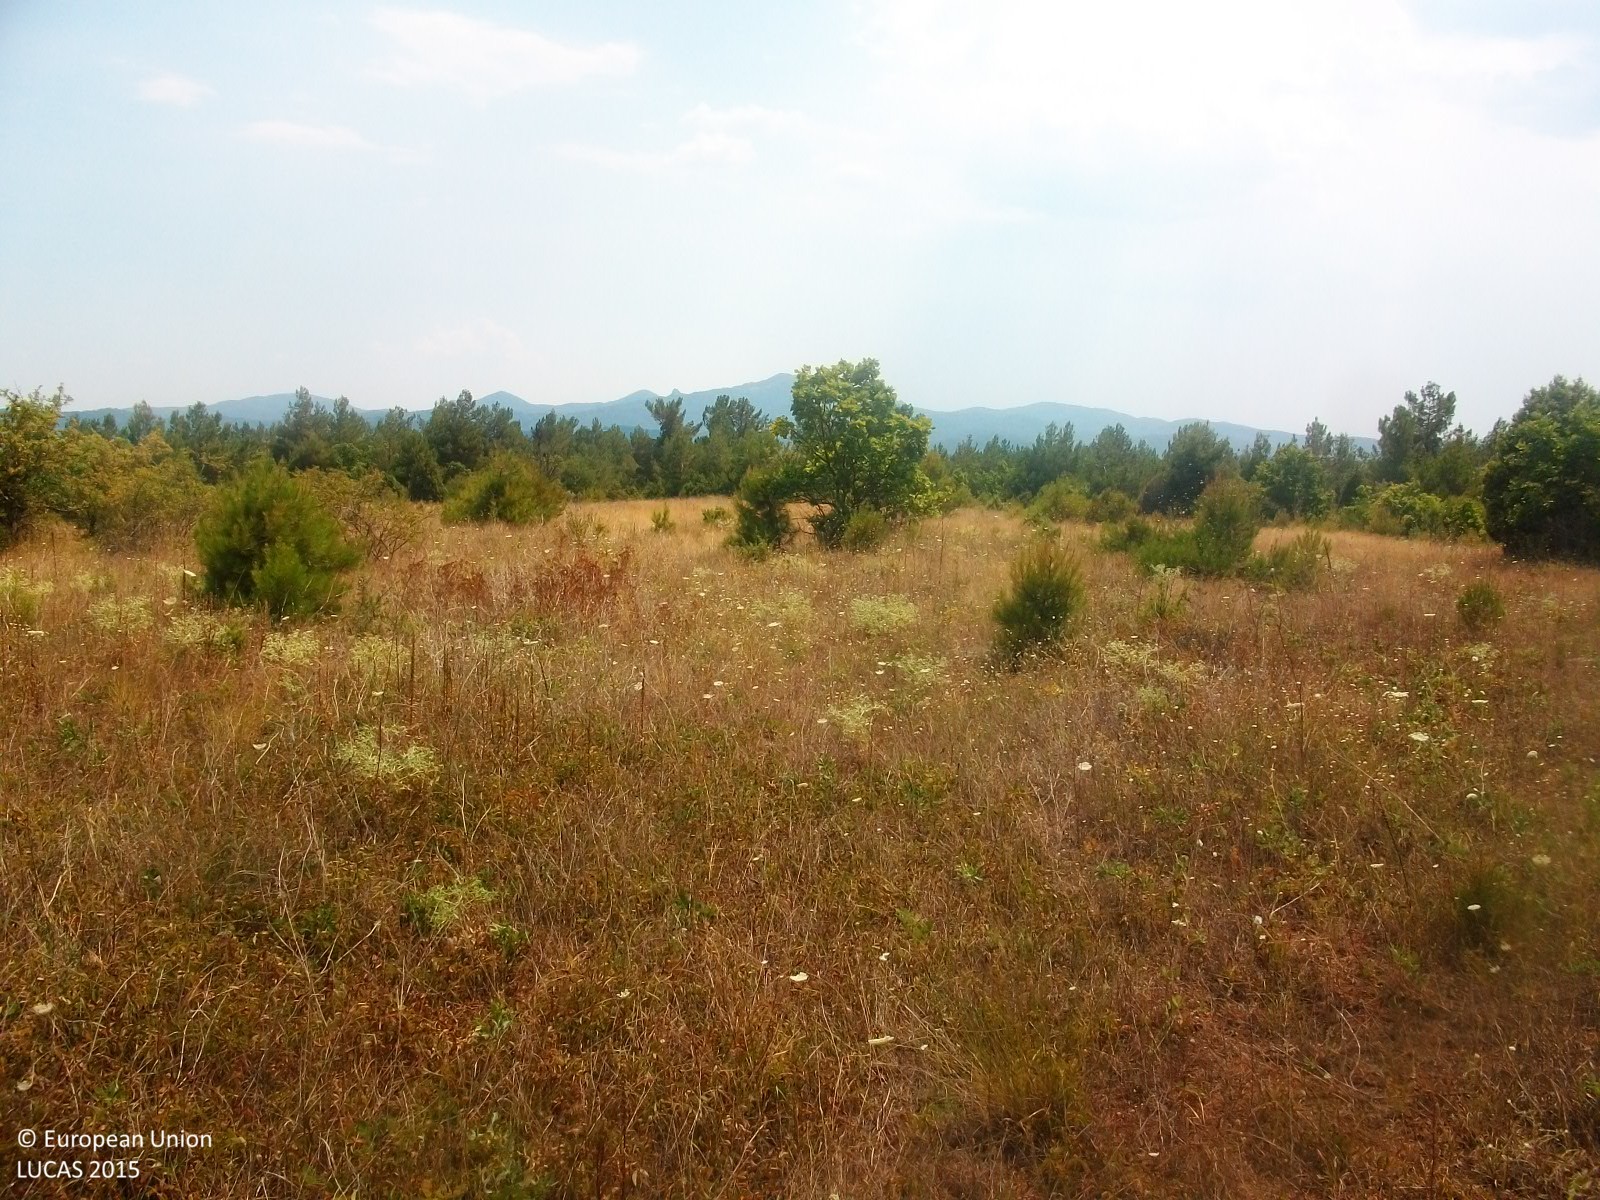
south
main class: Grassland
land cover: Grassland with sparse tree/shrub cover
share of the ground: > 75 %
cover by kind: herbaceous plants 90 %, broadleaved forest trees 5 %, shrubs 5 %
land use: Abandoned areas
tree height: < 5 m
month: July
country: GR
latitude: 41.1651
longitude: 26.1439
